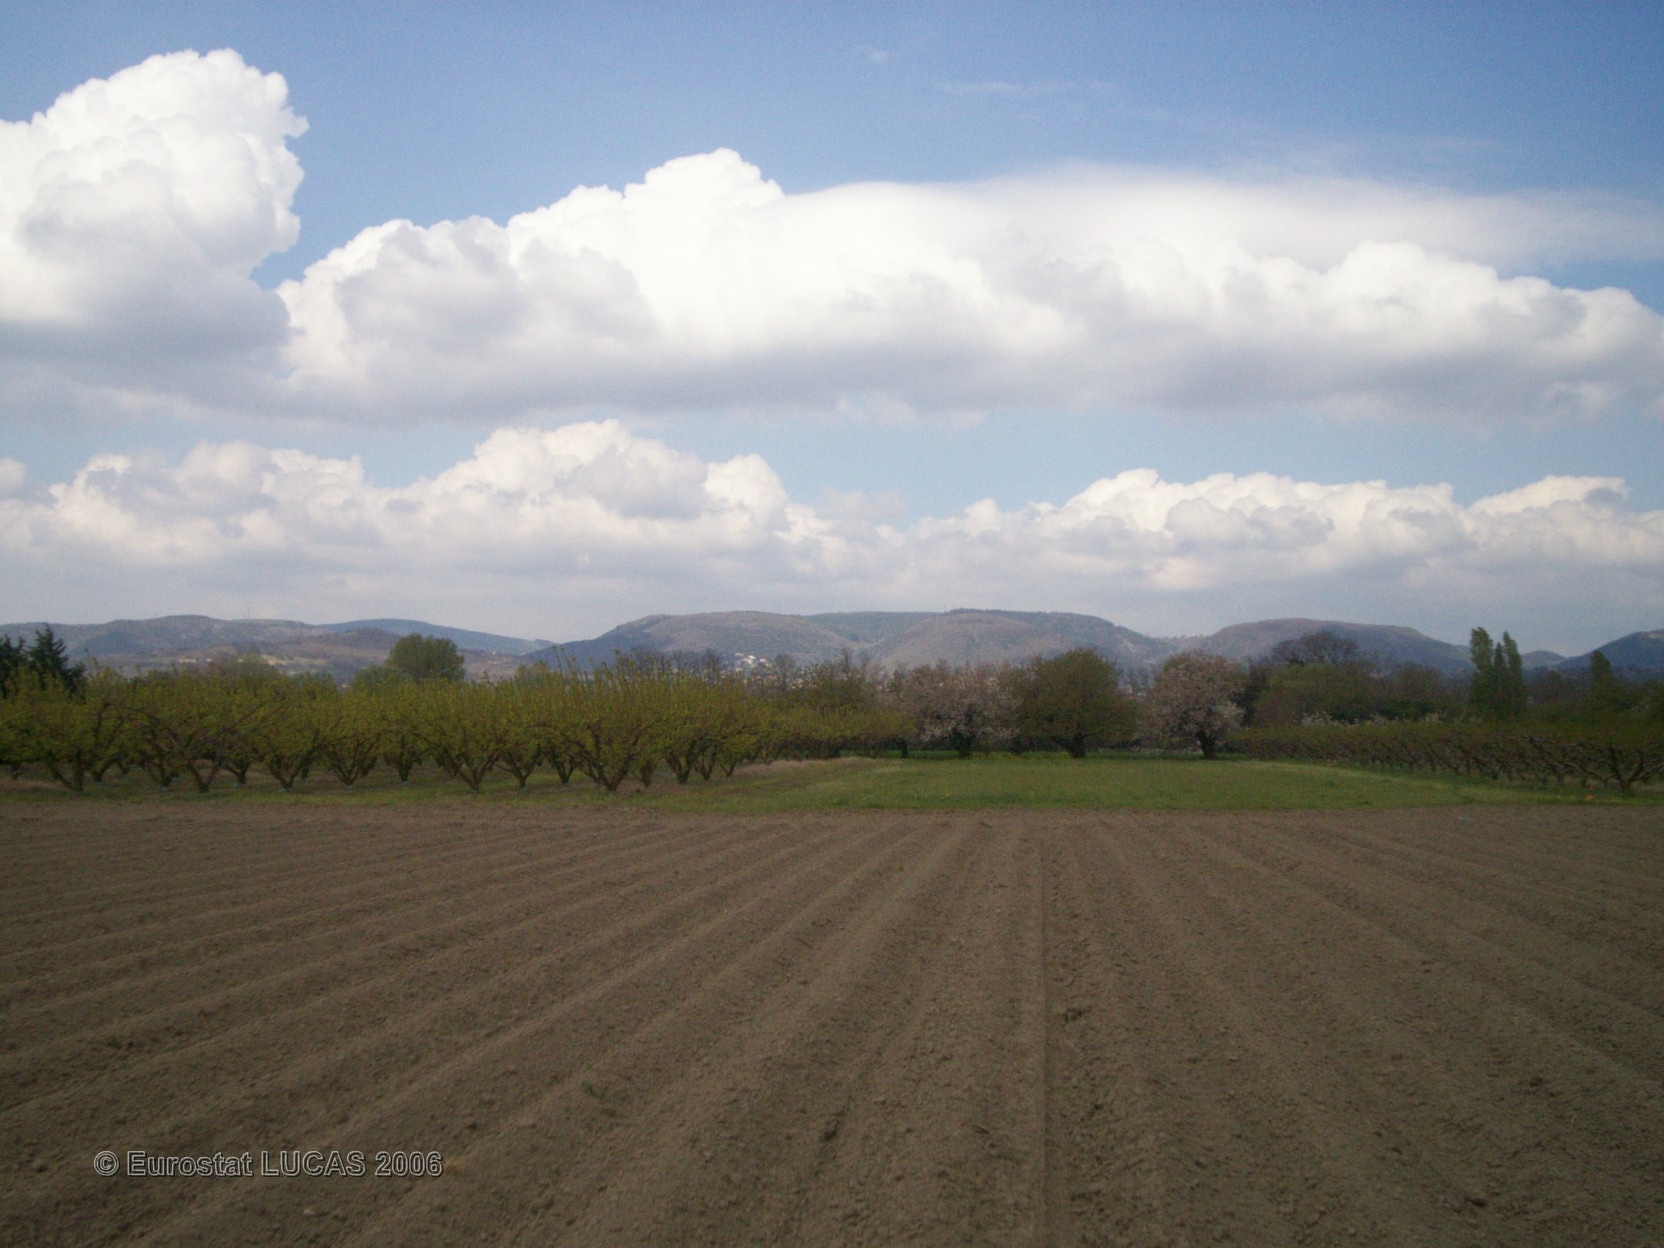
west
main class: Cropland
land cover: Potatoes
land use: Agriculture (excluding fallow land and kitchen gardens)
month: June
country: FR
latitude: 44.8553
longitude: 4.8557
